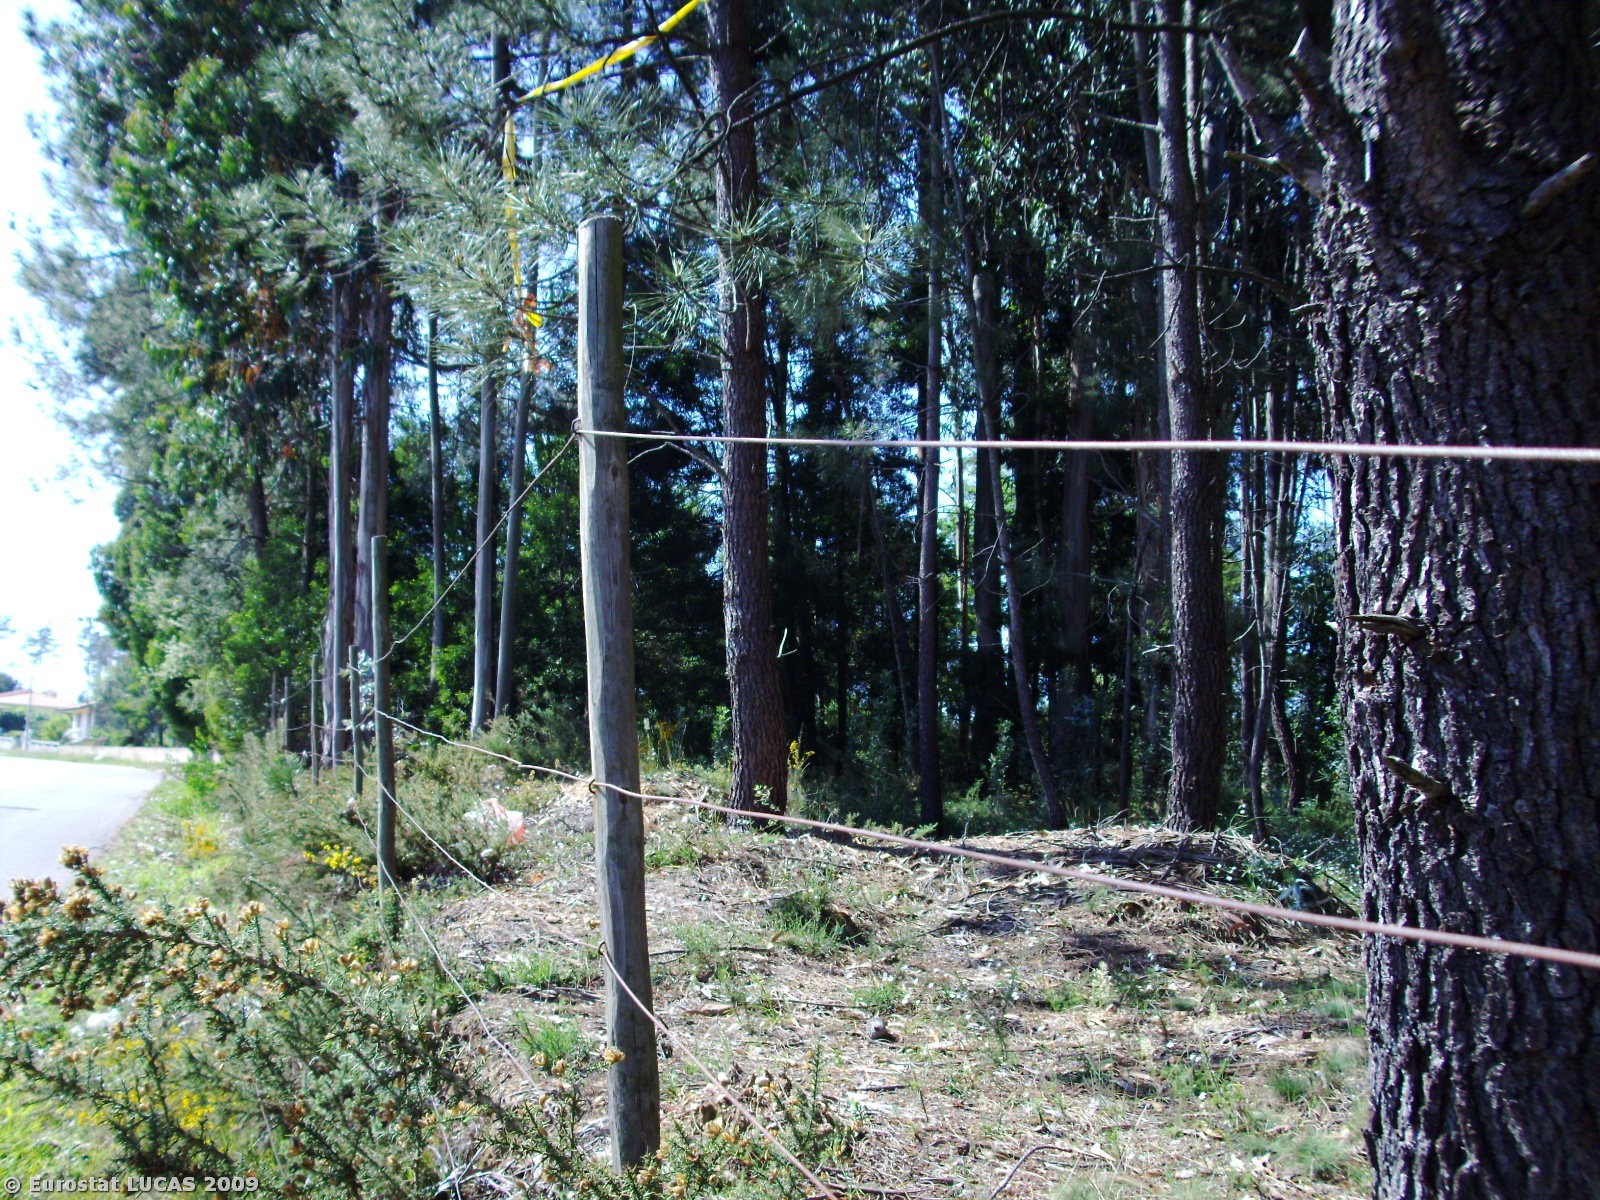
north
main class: Woodland
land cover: Coniferous woodland
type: coniferous forest of the mediterranean region
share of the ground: > 75 %
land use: Forestry
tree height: > 5 m
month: May
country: PT
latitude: 40.6096
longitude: -8.4460
